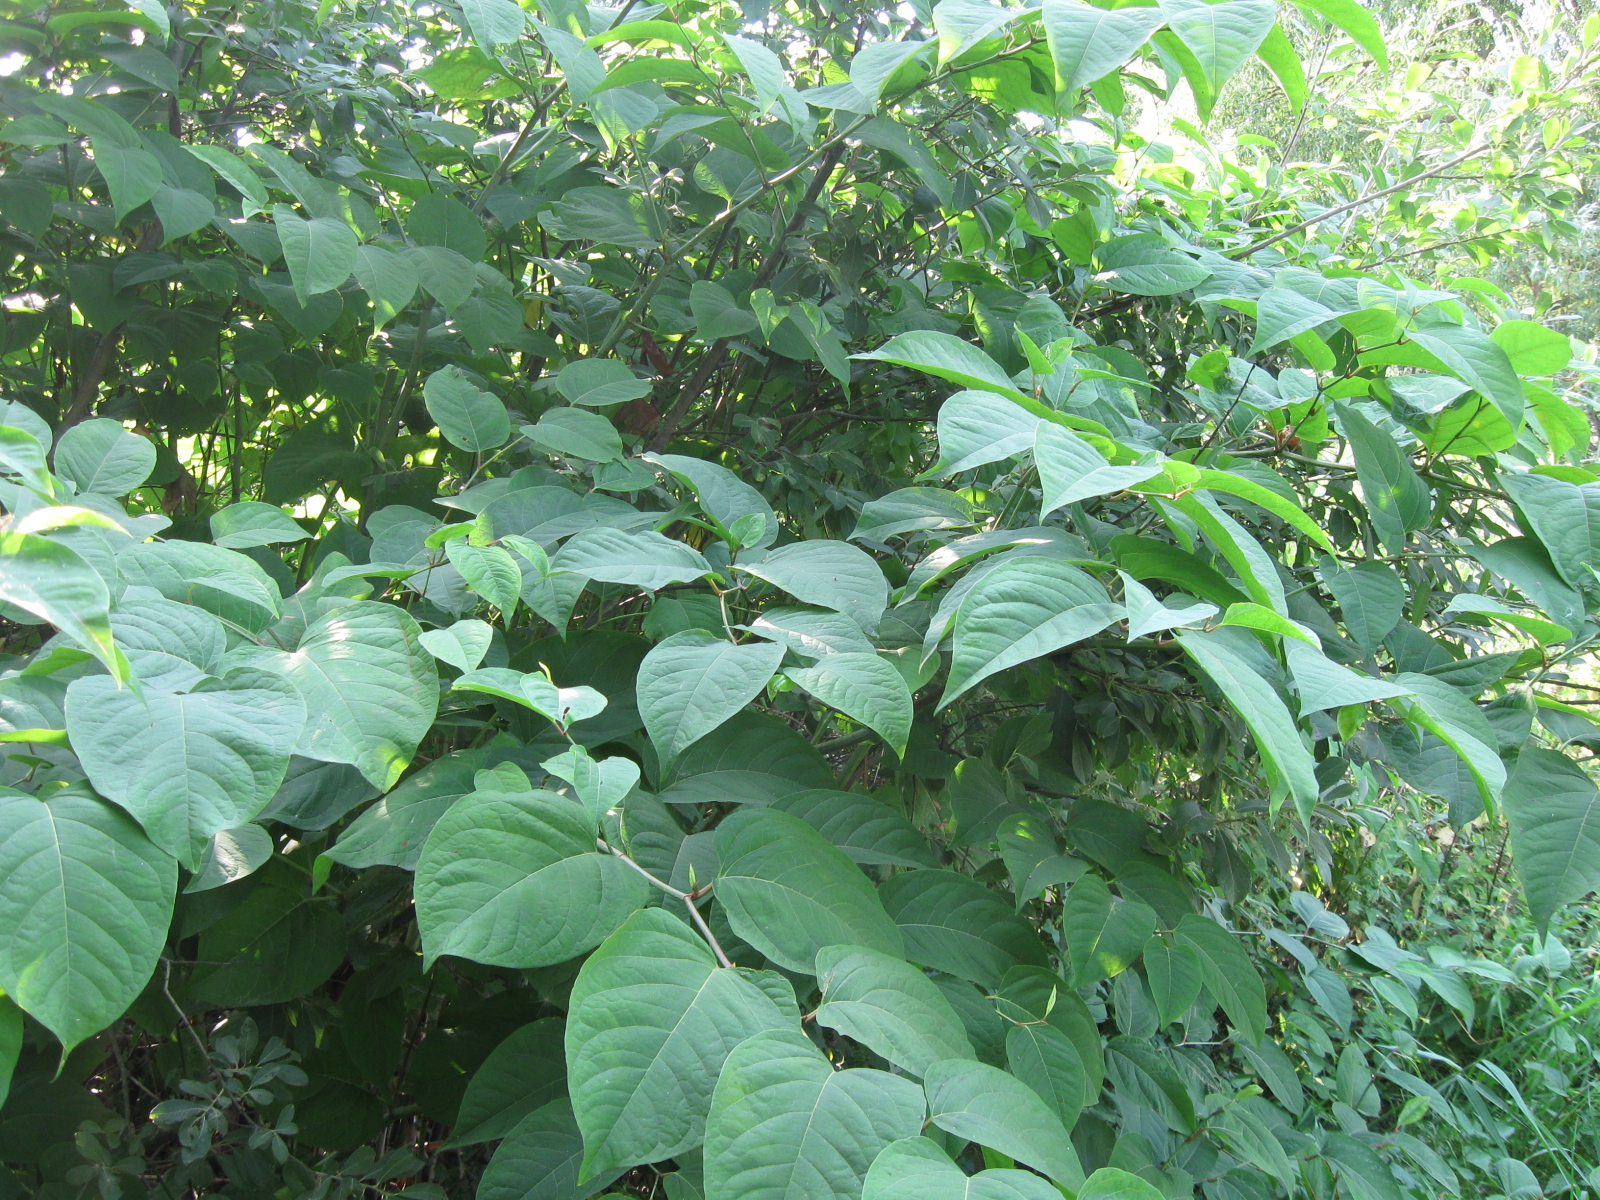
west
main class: Cropland
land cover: Apple fruit
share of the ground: 10 - 25 %
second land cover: Grassland without tree/shrub cover
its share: > 75 %
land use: Kitchen garden
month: August
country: LT
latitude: 54.4374
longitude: 23.2597
